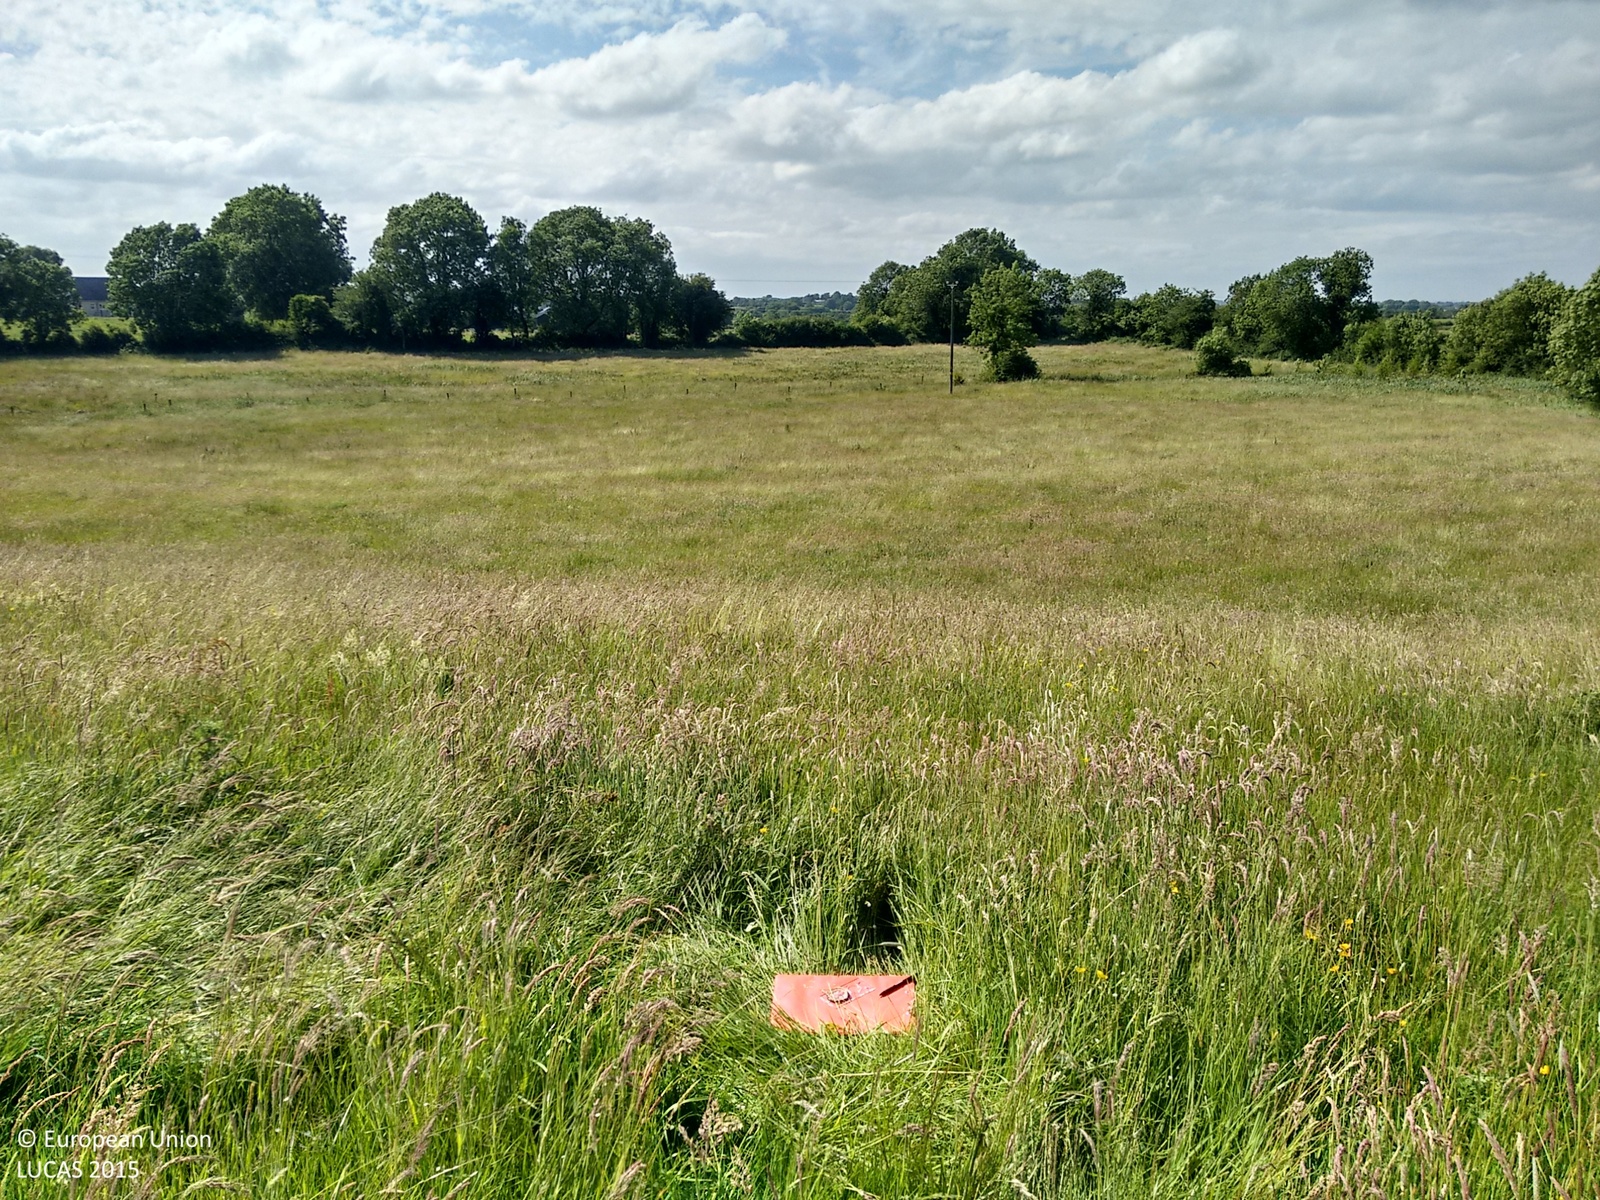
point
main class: Grassland
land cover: Grassland without tree/shrub cover
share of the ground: > 75 %
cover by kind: herbaceous plants 100 %
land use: Agriculture (excluding fallow land and kitchen gardens)
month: June
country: IE
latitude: 53.4374
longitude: -7.7643
